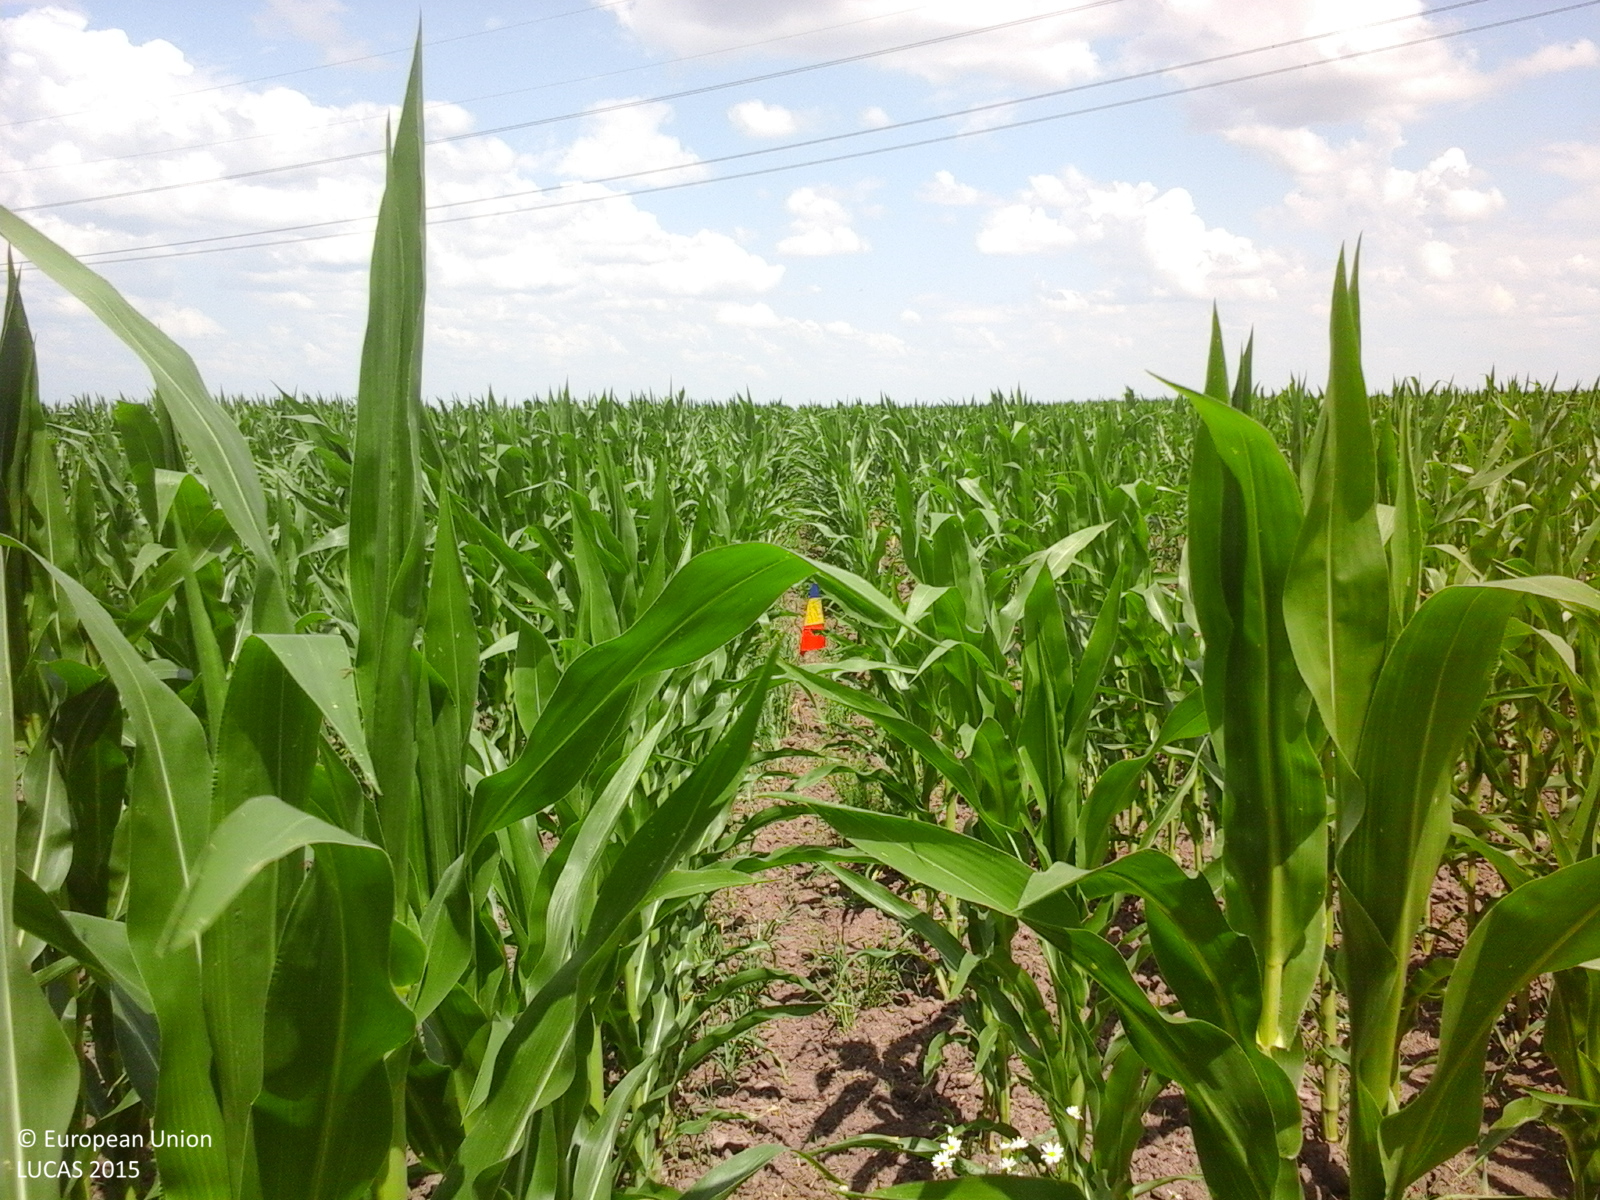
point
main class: Cropland
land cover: Maize
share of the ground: > 75 %
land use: Agriculture (excluding fallow land and kitchen gardens)
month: July
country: RO
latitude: 44.2554
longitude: 25.4050
